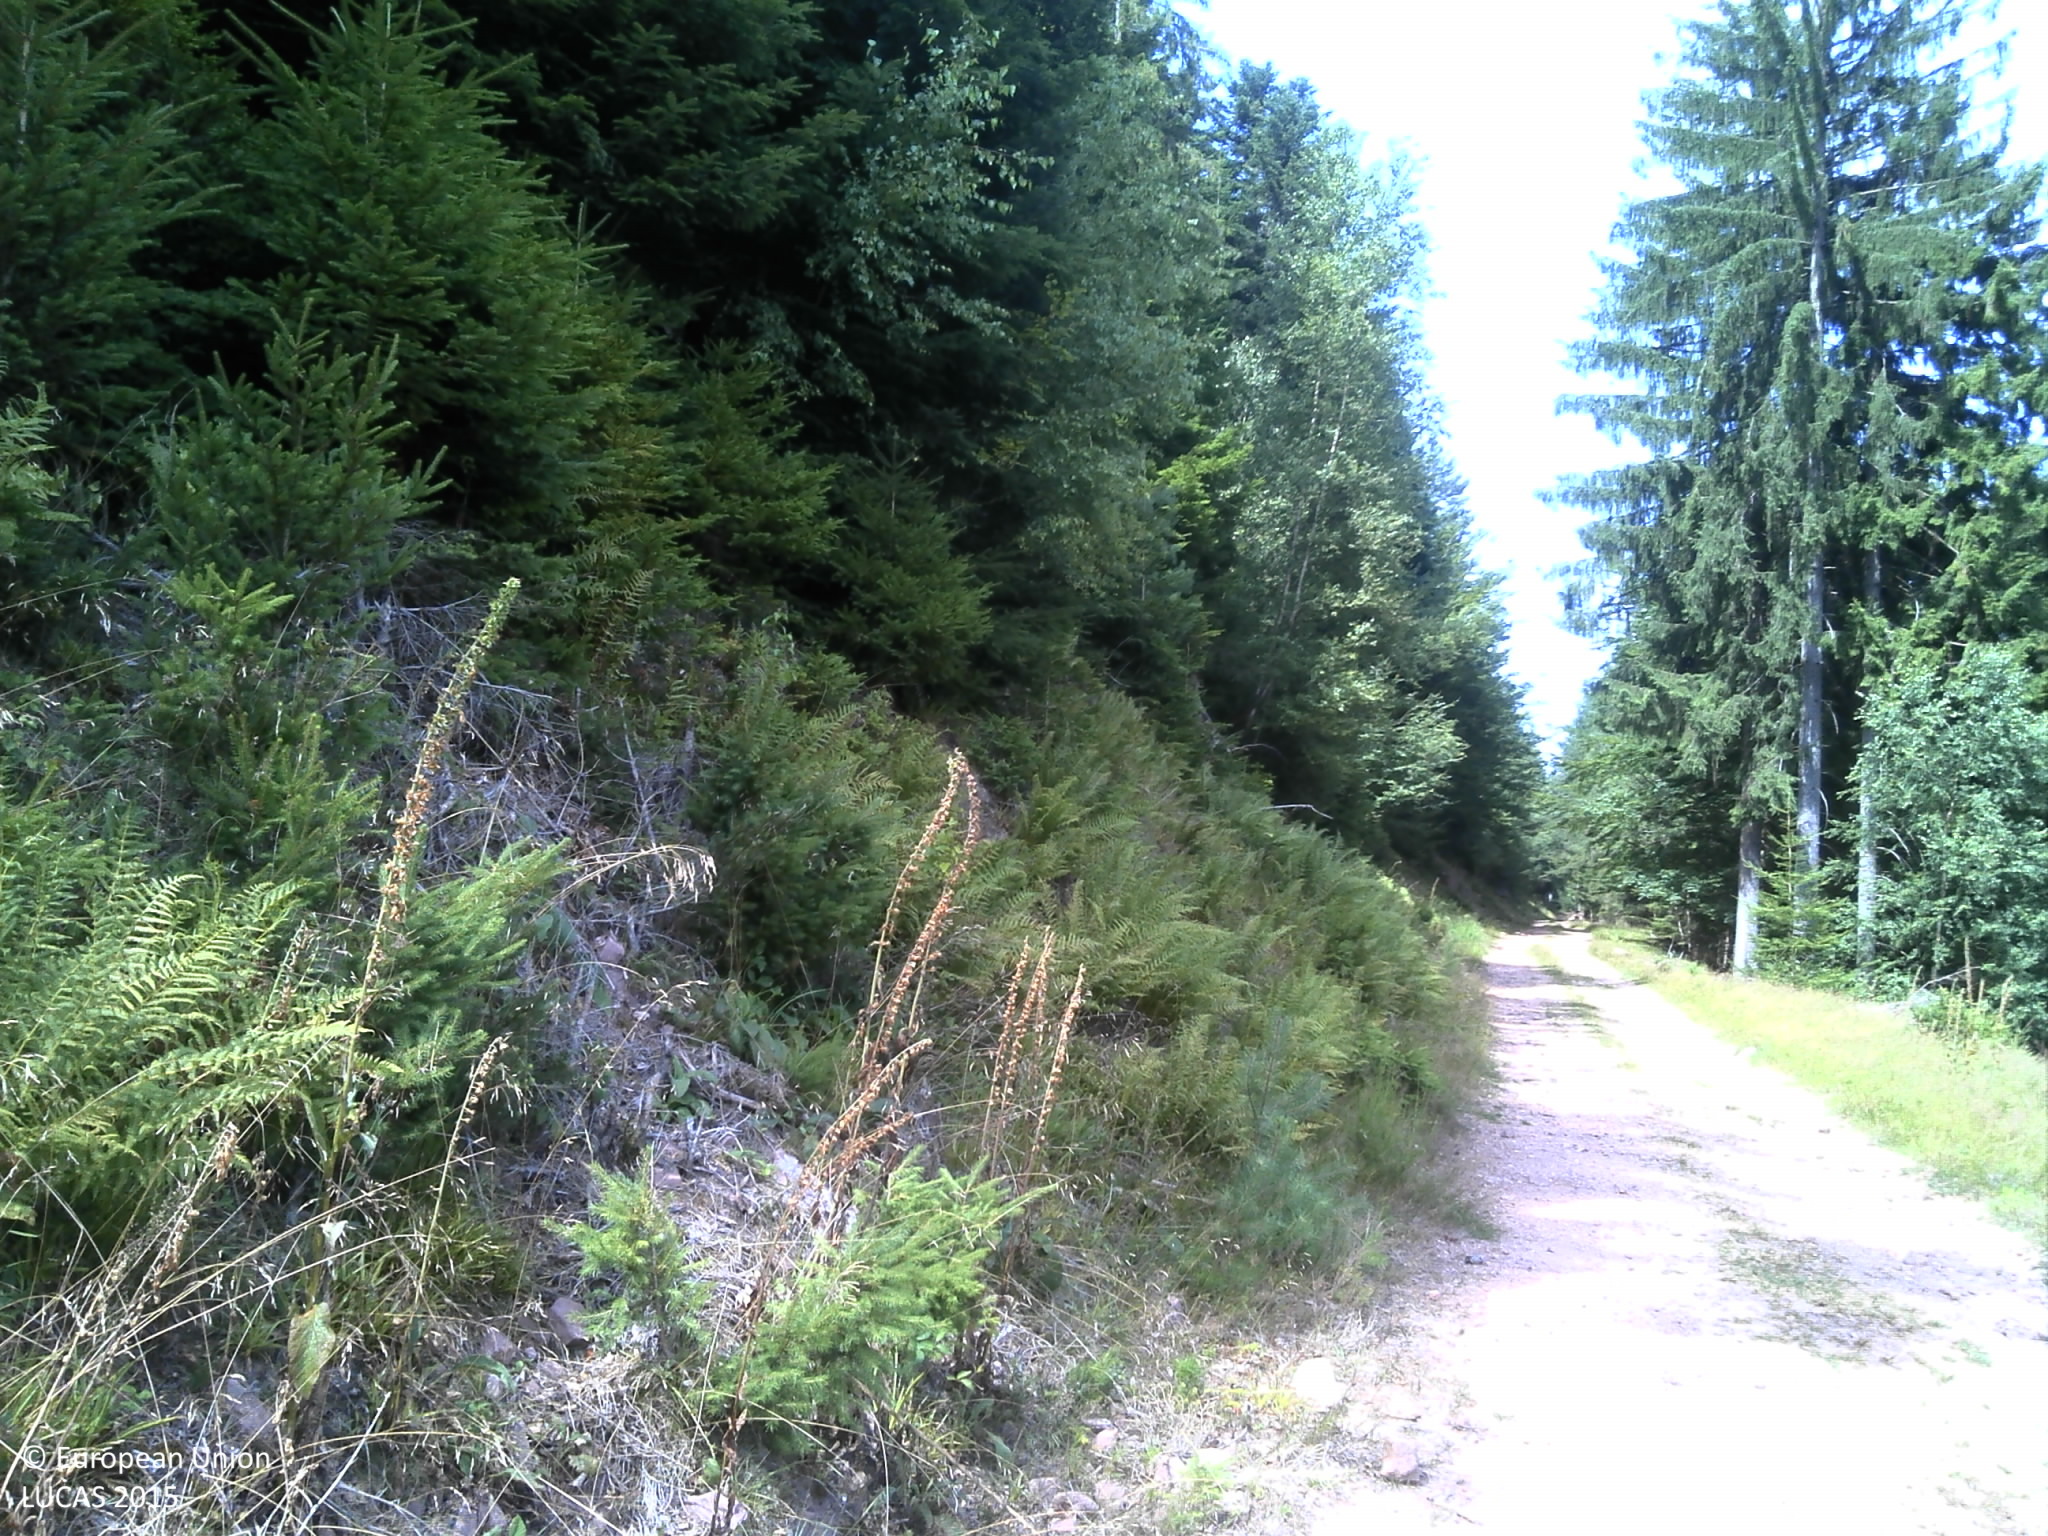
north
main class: Woodland
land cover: Spruce dominated mixed woodland
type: hemiboreal forest and nemoral coniferous forest and mixed broadleaved-coniferous forest
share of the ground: > 75 %
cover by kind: coniferous forest trees 40 %, broadleaved forest trees 40 %, shrubs 10 %, herbaceous plants 10 %
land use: Forestry
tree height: > 5 m
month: July
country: FR
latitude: 48.6219
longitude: 7.2739
